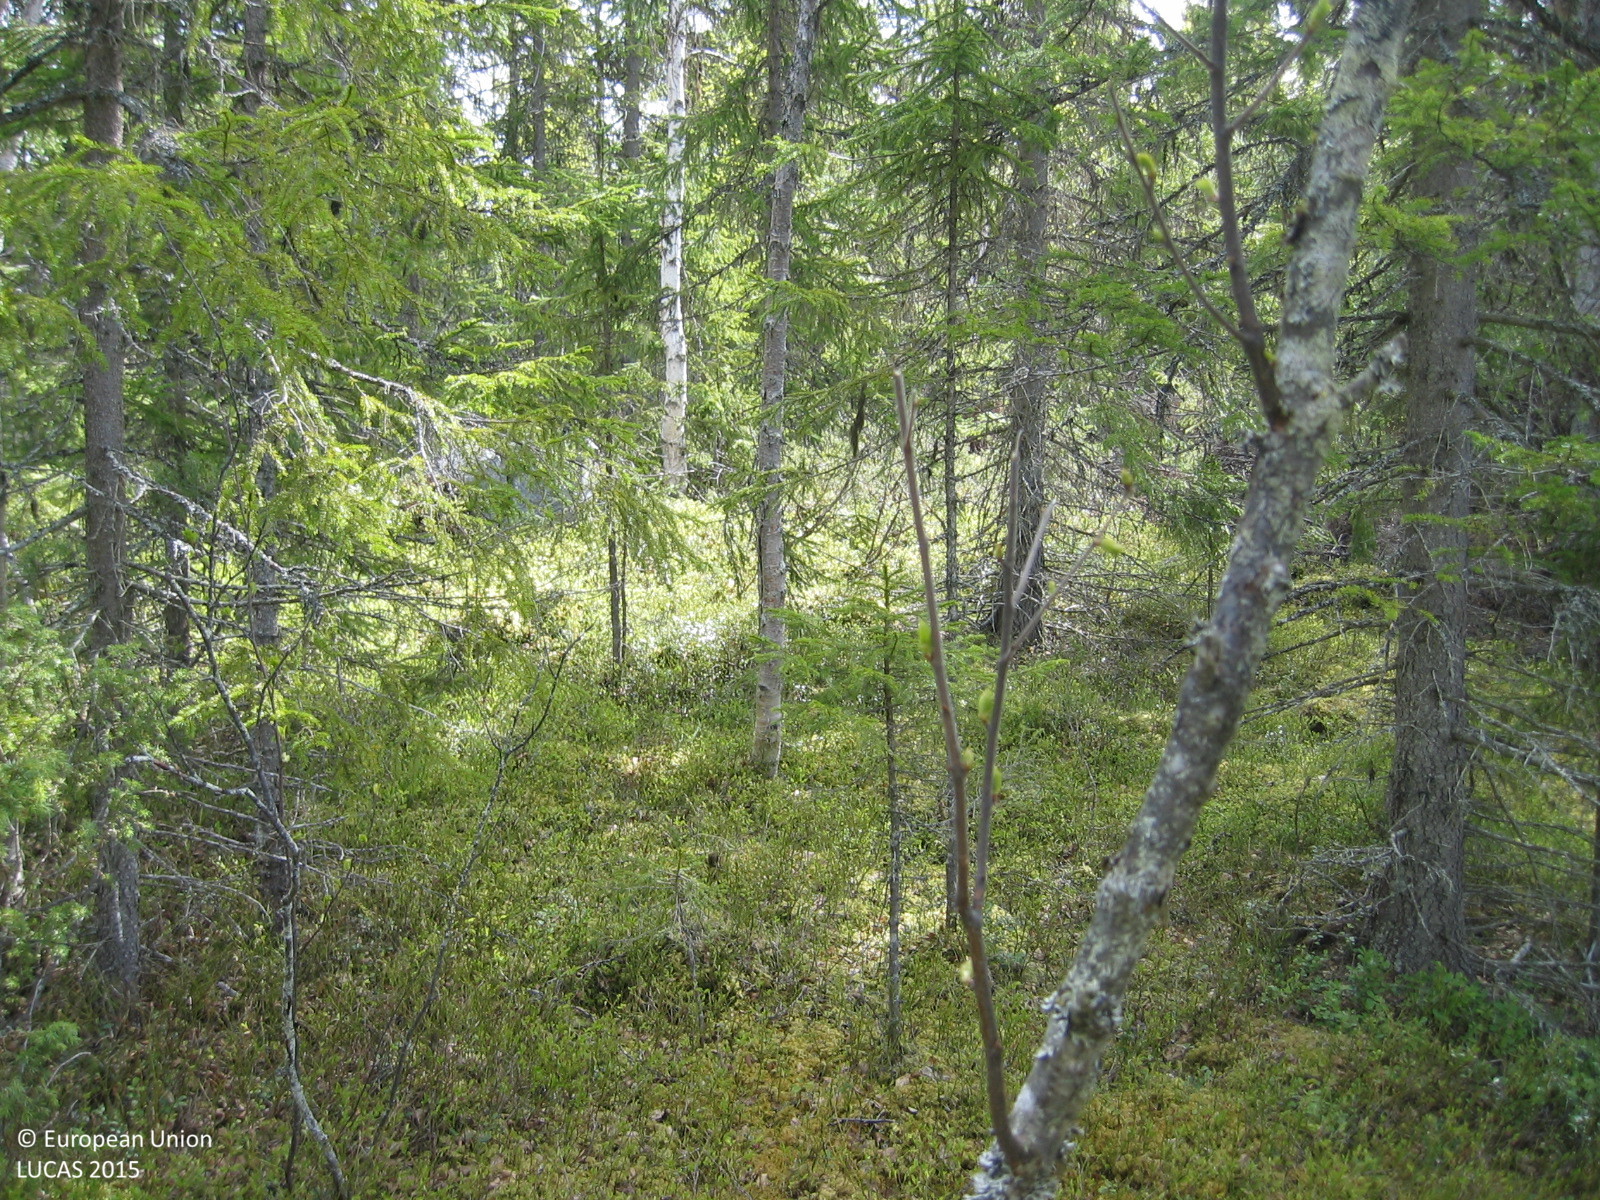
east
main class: Woodland
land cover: Spruce dominated mixed woodland
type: boreal forest
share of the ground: > 75 %
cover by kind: coniferous forest trees 60 %, broadleaved forest trees 20 %, shrubs 20 %
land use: Forestry
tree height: > 5 m
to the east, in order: Spruce dominated mixed woodland; Rivers and streams; Spruce dominated mixed woodland; Tracks; Spruce dominated mixed woodland
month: June
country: SE
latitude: 63.6799
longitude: 13.9615
